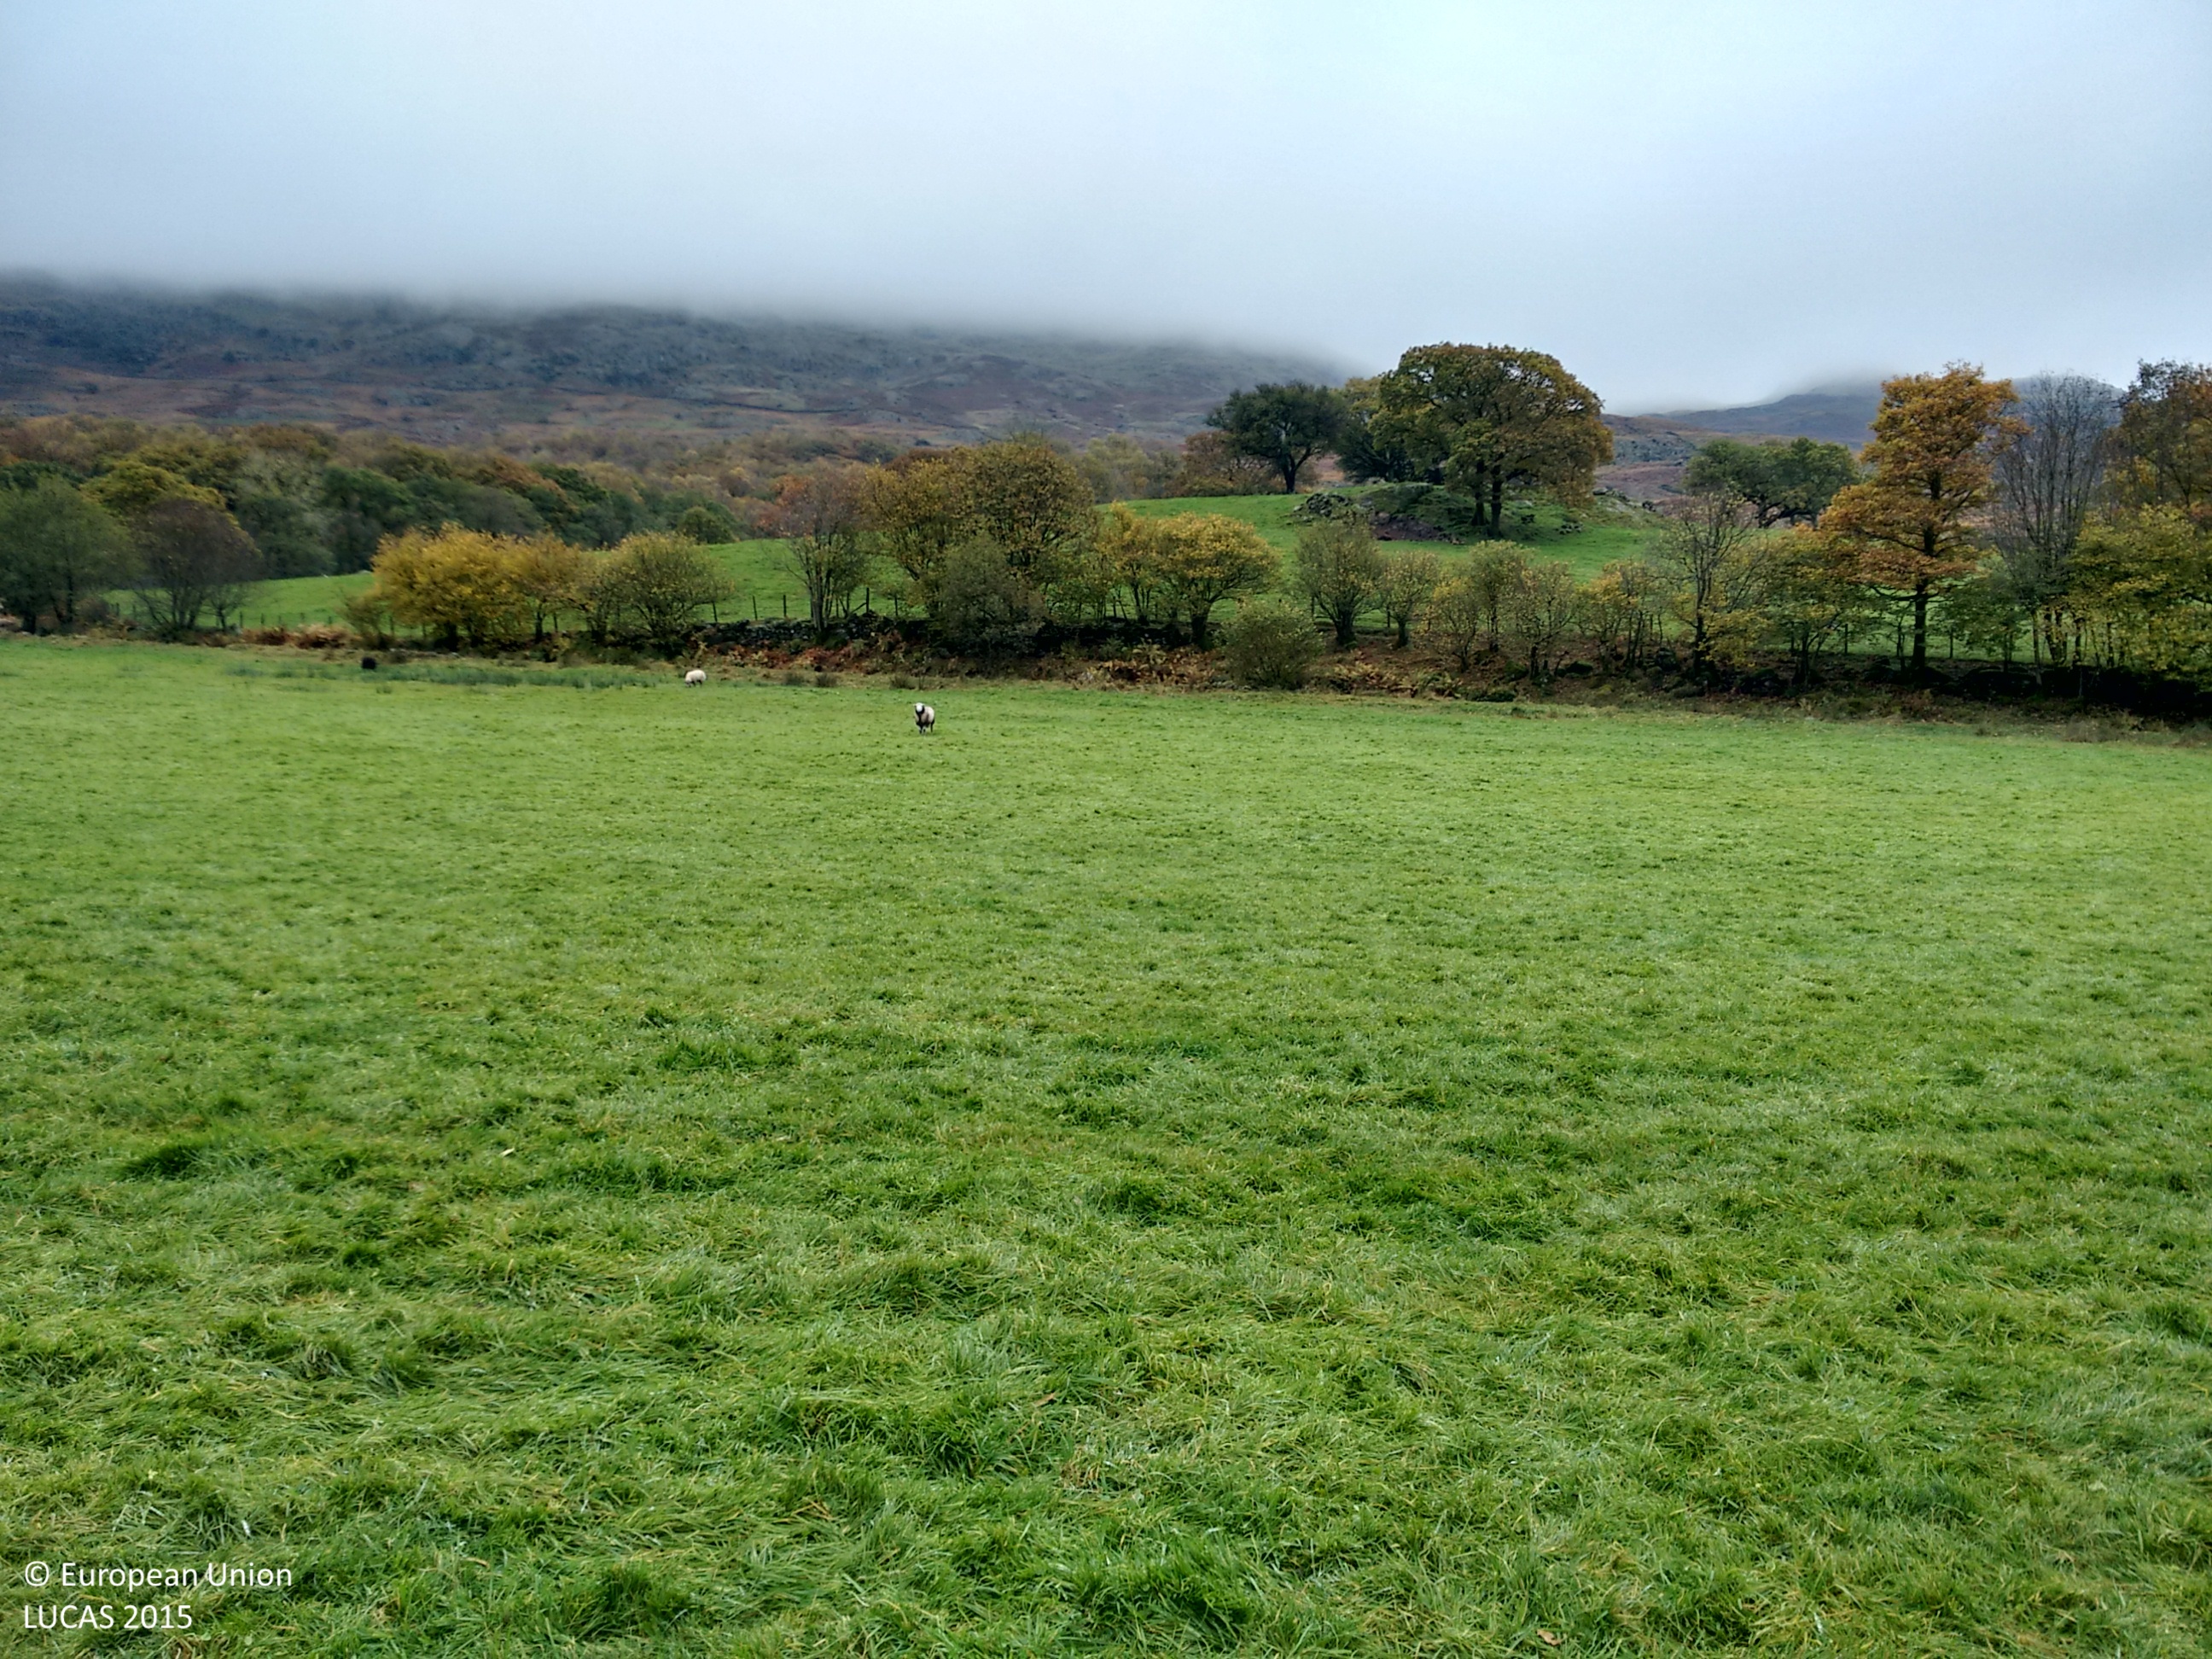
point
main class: Grassland
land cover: Grassland without tree/shrub cover
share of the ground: > 75 %
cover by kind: herbaceous plants 100 %
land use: Agriculture (excluding fallow land and kitchen gardens)
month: October
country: GB
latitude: 54.3526
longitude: -3.2008
